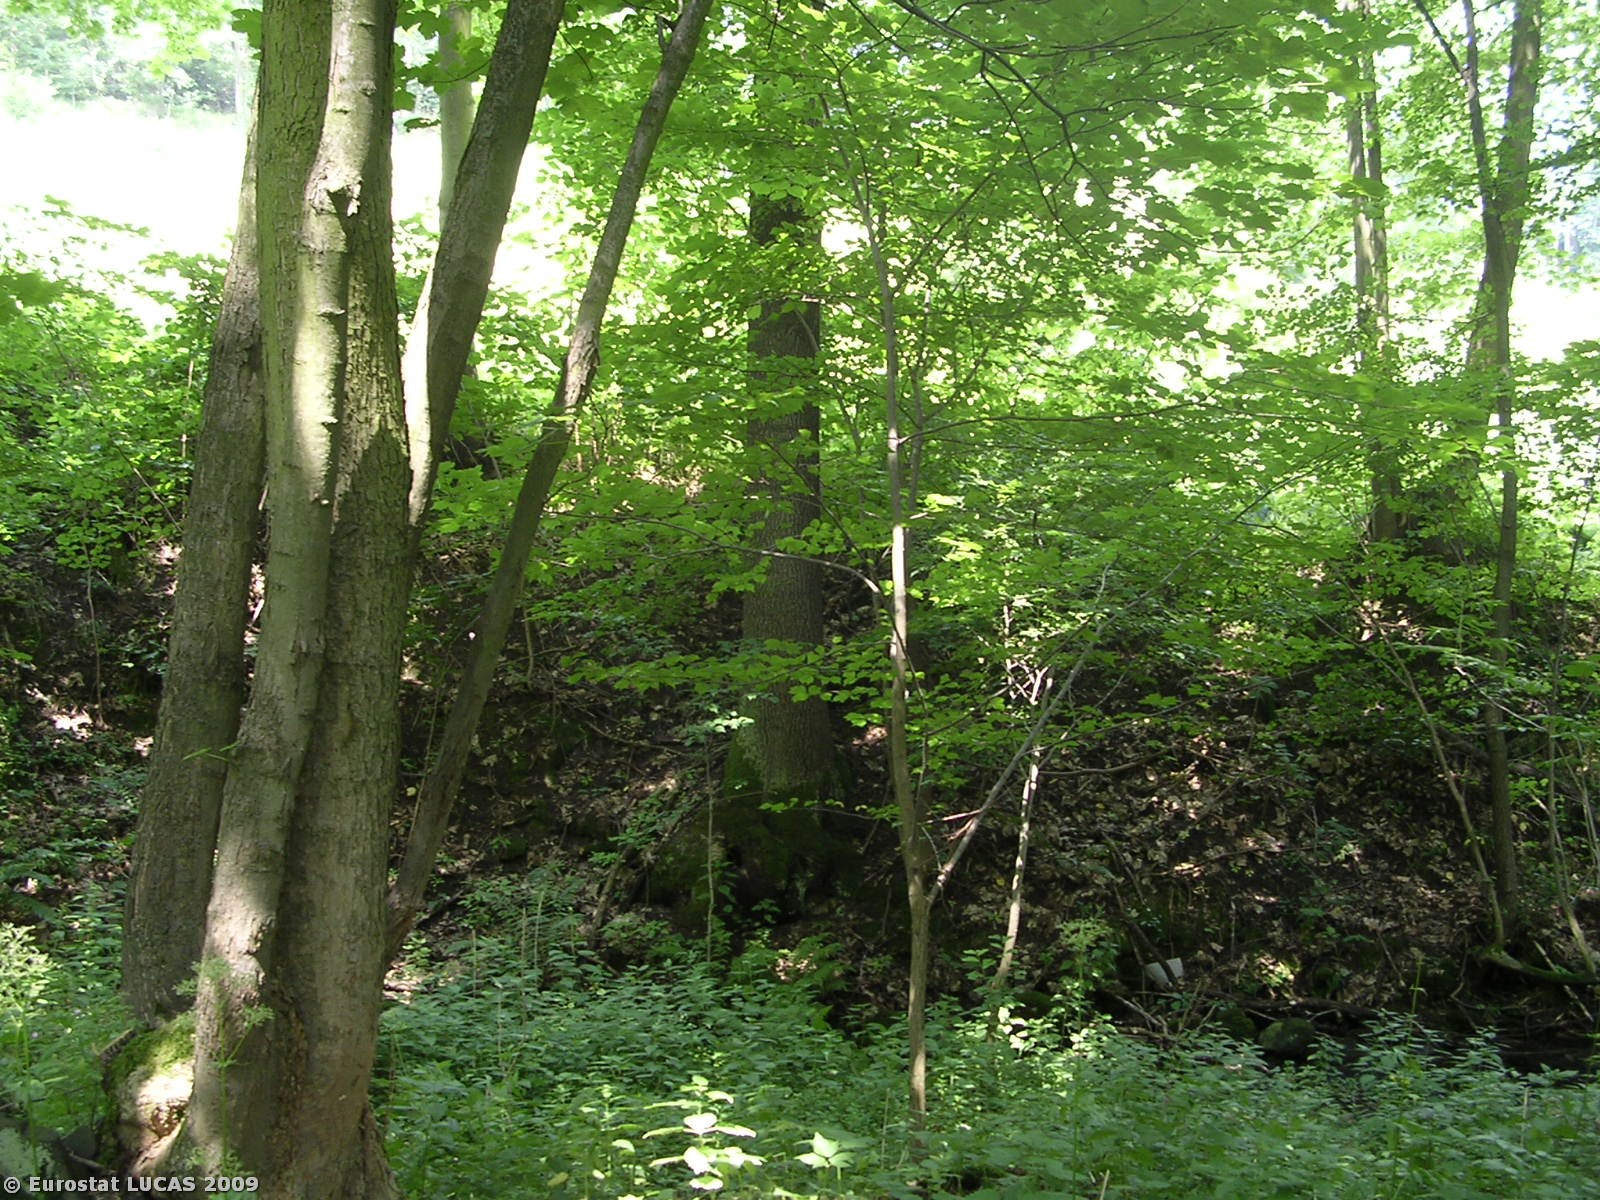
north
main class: Woodland
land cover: Broadleaved woodland
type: mesophytic deciduous forest
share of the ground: > 75 %
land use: Forestry
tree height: > 5 m
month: June
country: CZ
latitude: 50.7167
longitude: 14.2646
